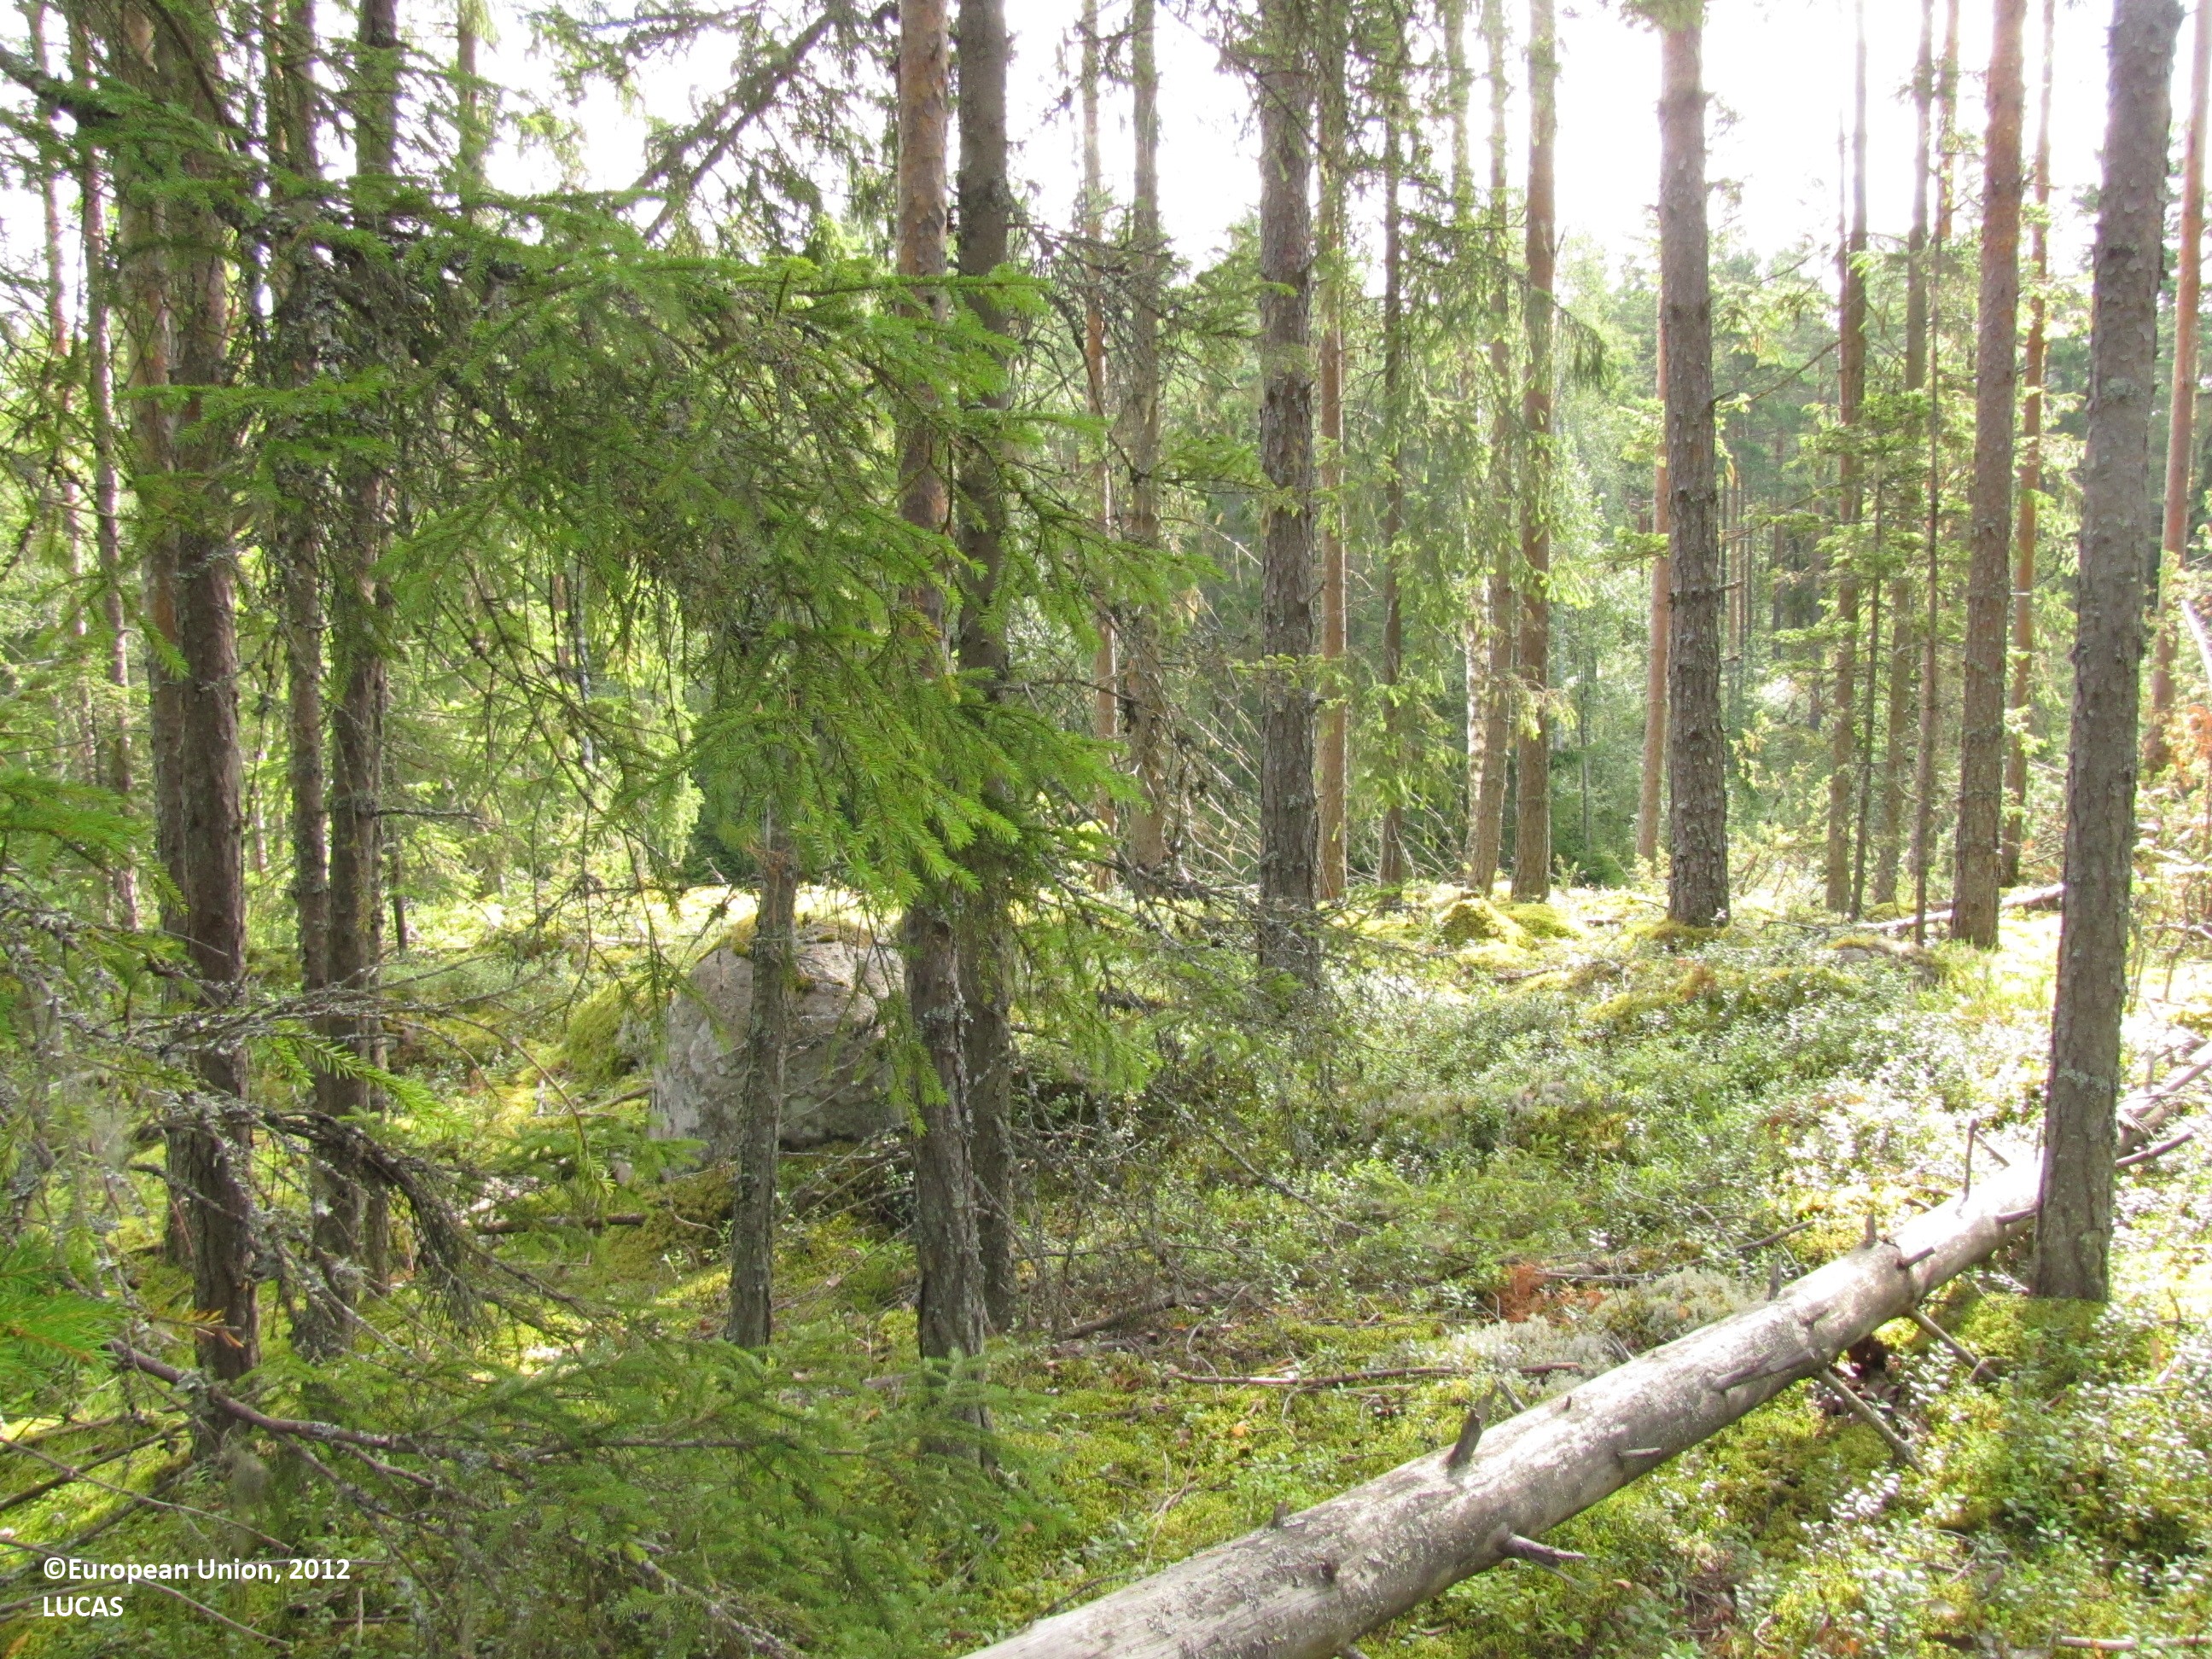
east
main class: Woodland
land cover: Other coniferous woodland
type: boreal forest
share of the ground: 50 - 75 %
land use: Forestry
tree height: > 5 m
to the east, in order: Other coniferous woodland; Broadleaved woodland; Spruce dominated coniferous woodland; Ditches and canals; Other coniferous woodland
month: August
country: FI
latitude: 61.8062
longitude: 23.2208
